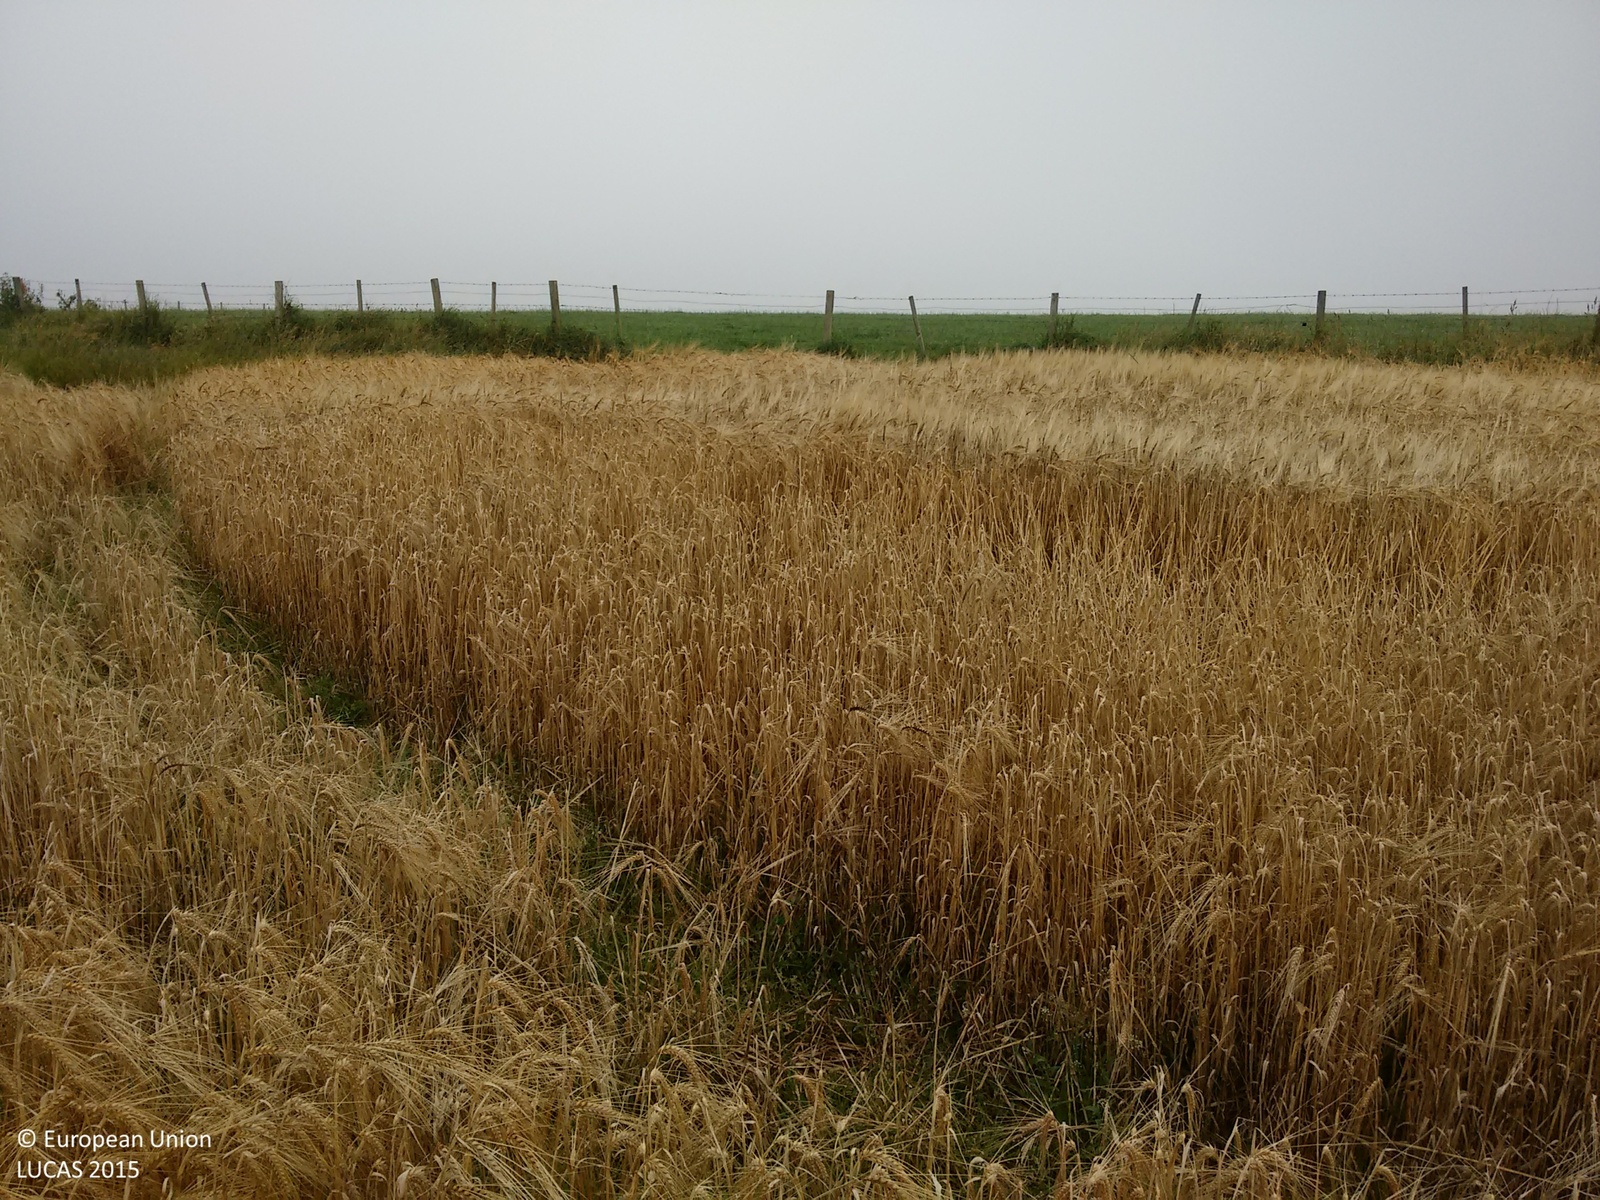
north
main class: Cropland
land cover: Barley
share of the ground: > 75 %
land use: Agriculture (excluding fallow land and kitchen gardens)
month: September
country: GB
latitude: 57.5193
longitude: -3.8173
